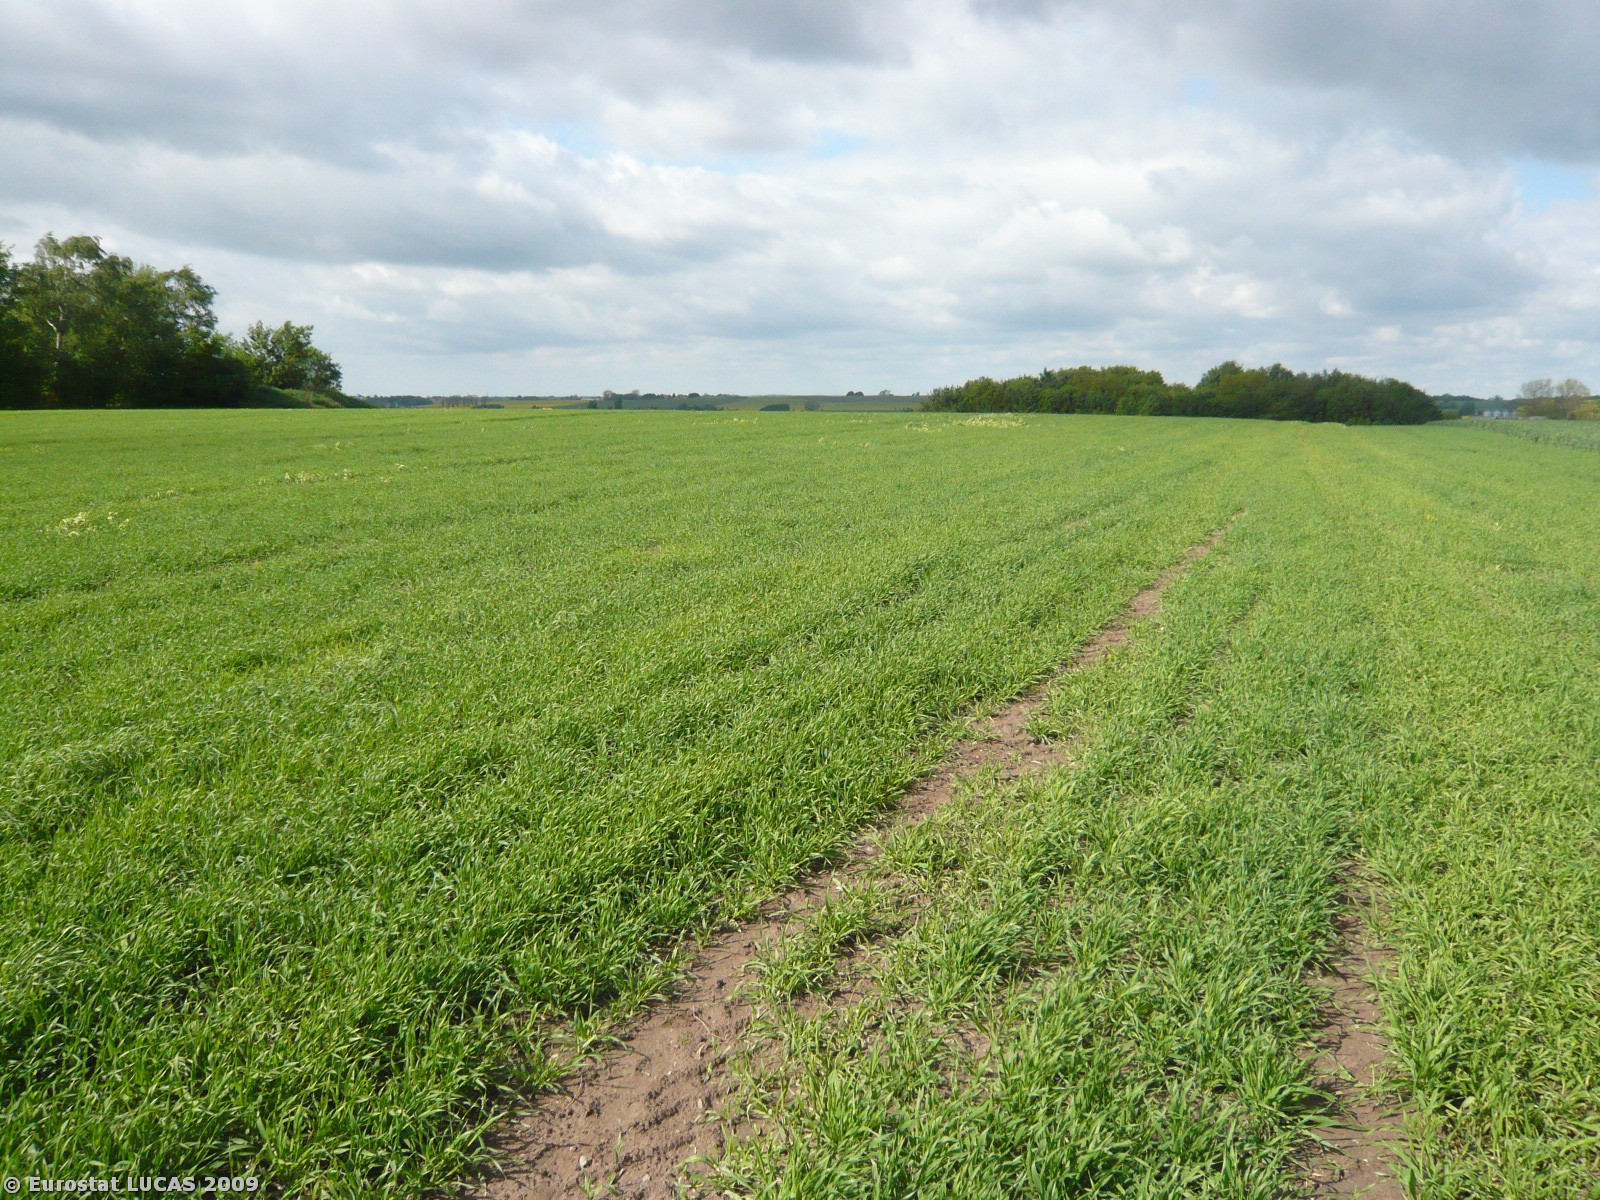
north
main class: Cropland
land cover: Barley
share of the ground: > 75 %
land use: Agriculture (excluding fallow land and kitchen gardens)
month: May
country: DK
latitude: 55.3676
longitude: 11.6868
